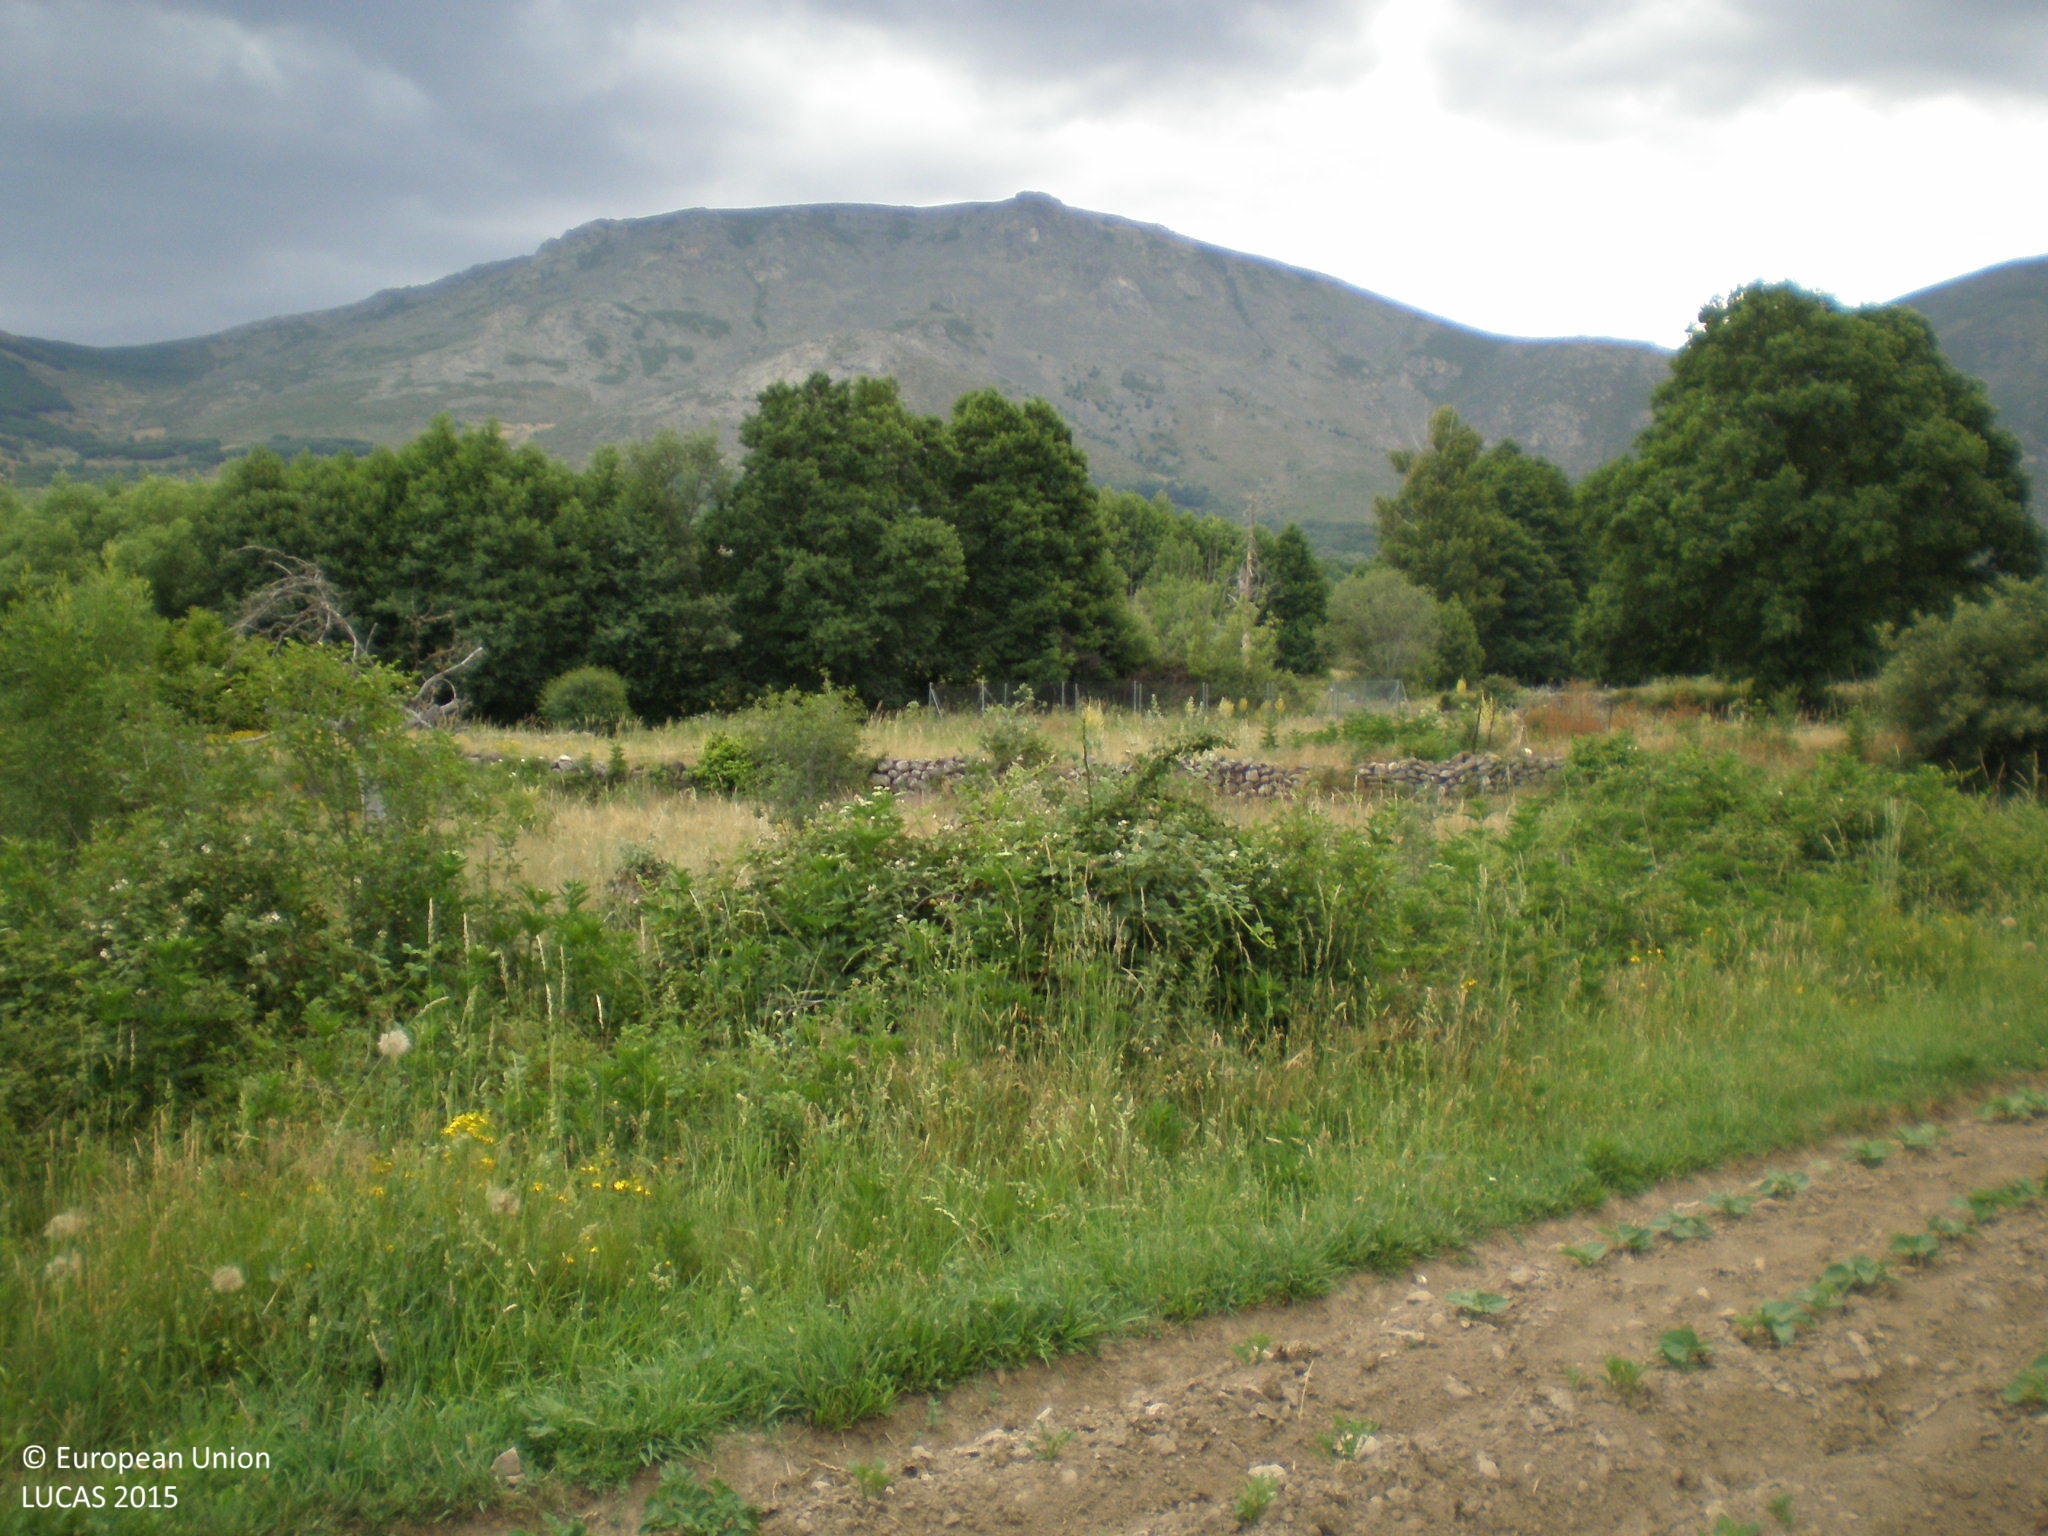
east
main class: Cropland
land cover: Potatoes
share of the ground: < 10 %
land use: Agriculture (excluding fallow land and kitchen gardens)
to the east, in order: Potatoes; Grassland without tree/shrub cover; Dry stone walls; Abandoned hedges; Grassland without tree/shrub cover; Artificial constructions in urban areas; Grassland without tree/shrub cover; Groves; Dry stone walls; Grassland without tree/shrub cover; Dry stone walls; Grassland with sparse tree/shrub cover; Fences; Grass margins; Paved roads, cycling and walking lanes; Grass margins; Dry stone walls; Grassland without tree/shrub cover; Electric lines; Grassland without tree/shrub cover
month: June
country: ES
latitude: 40.2760
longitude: -5.5060
